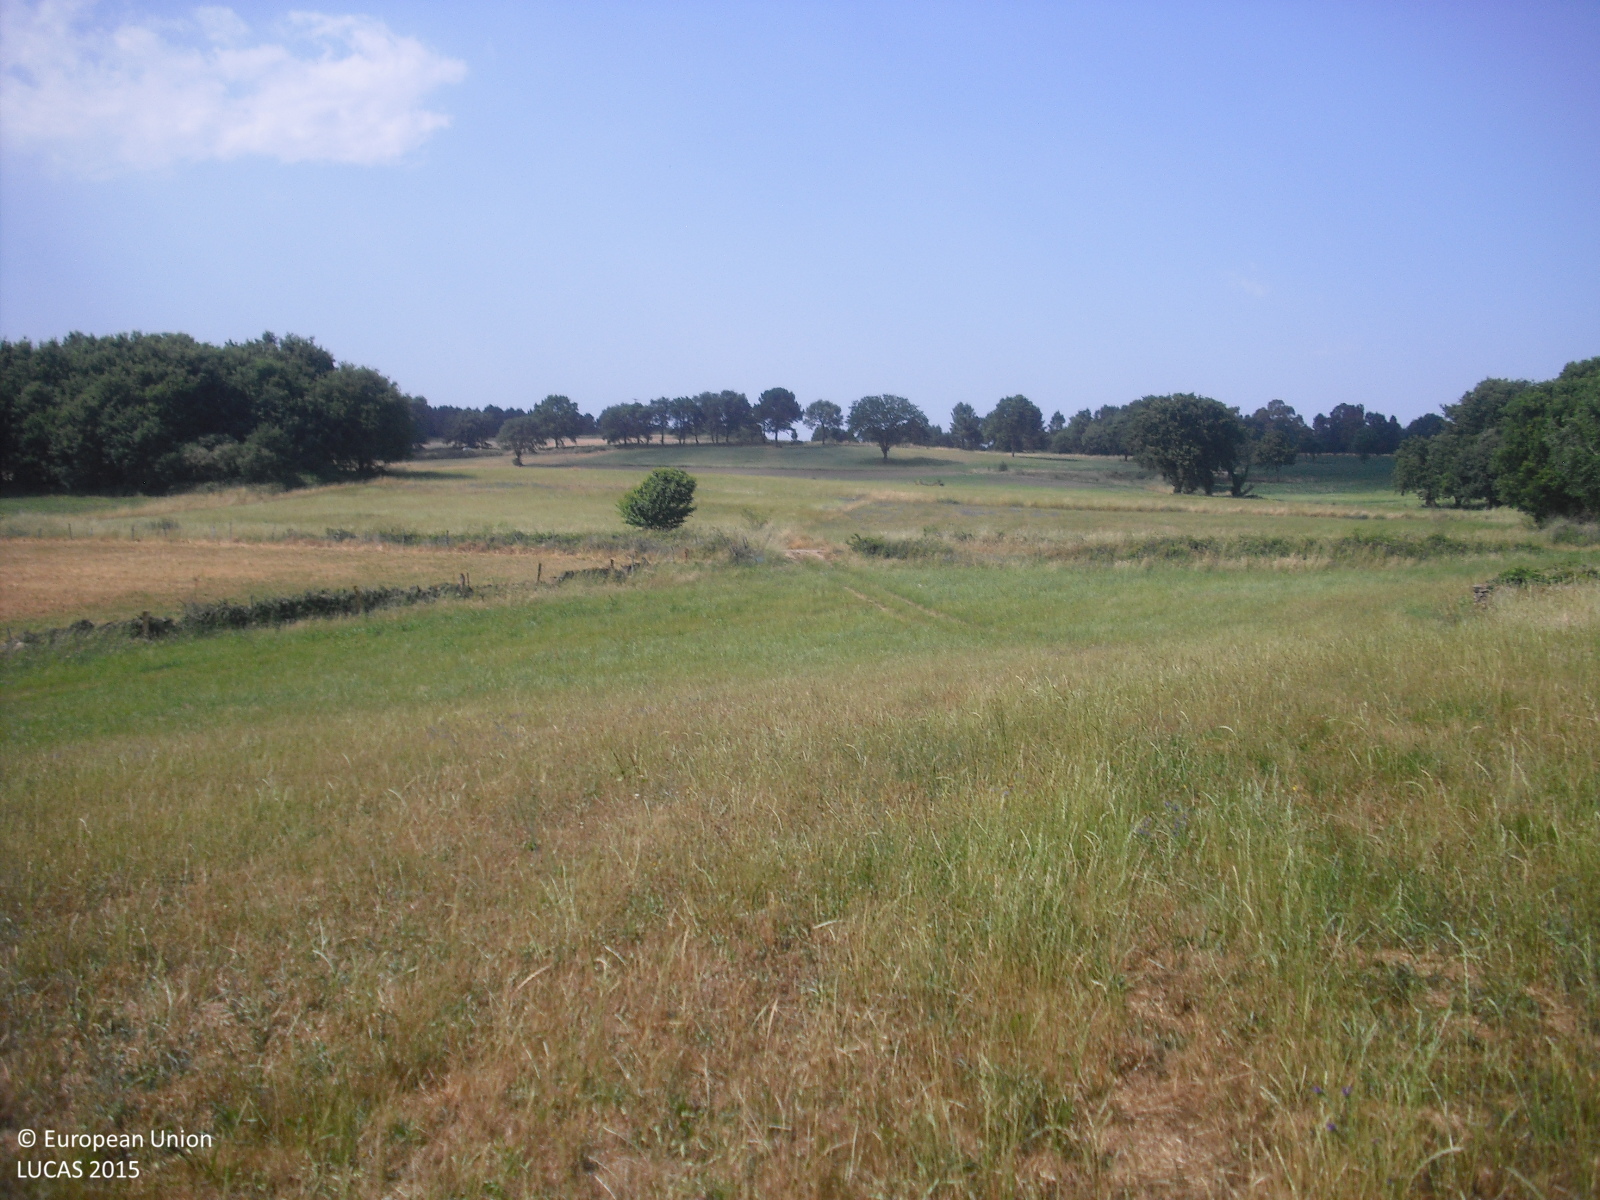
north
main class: Cropland
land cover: Temporary grasslands
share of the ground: > 75 %
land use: Agriculture (excluding fallow land and kitchen gardens)
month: June
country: ES
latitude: 42.6091
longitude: -7.8154
